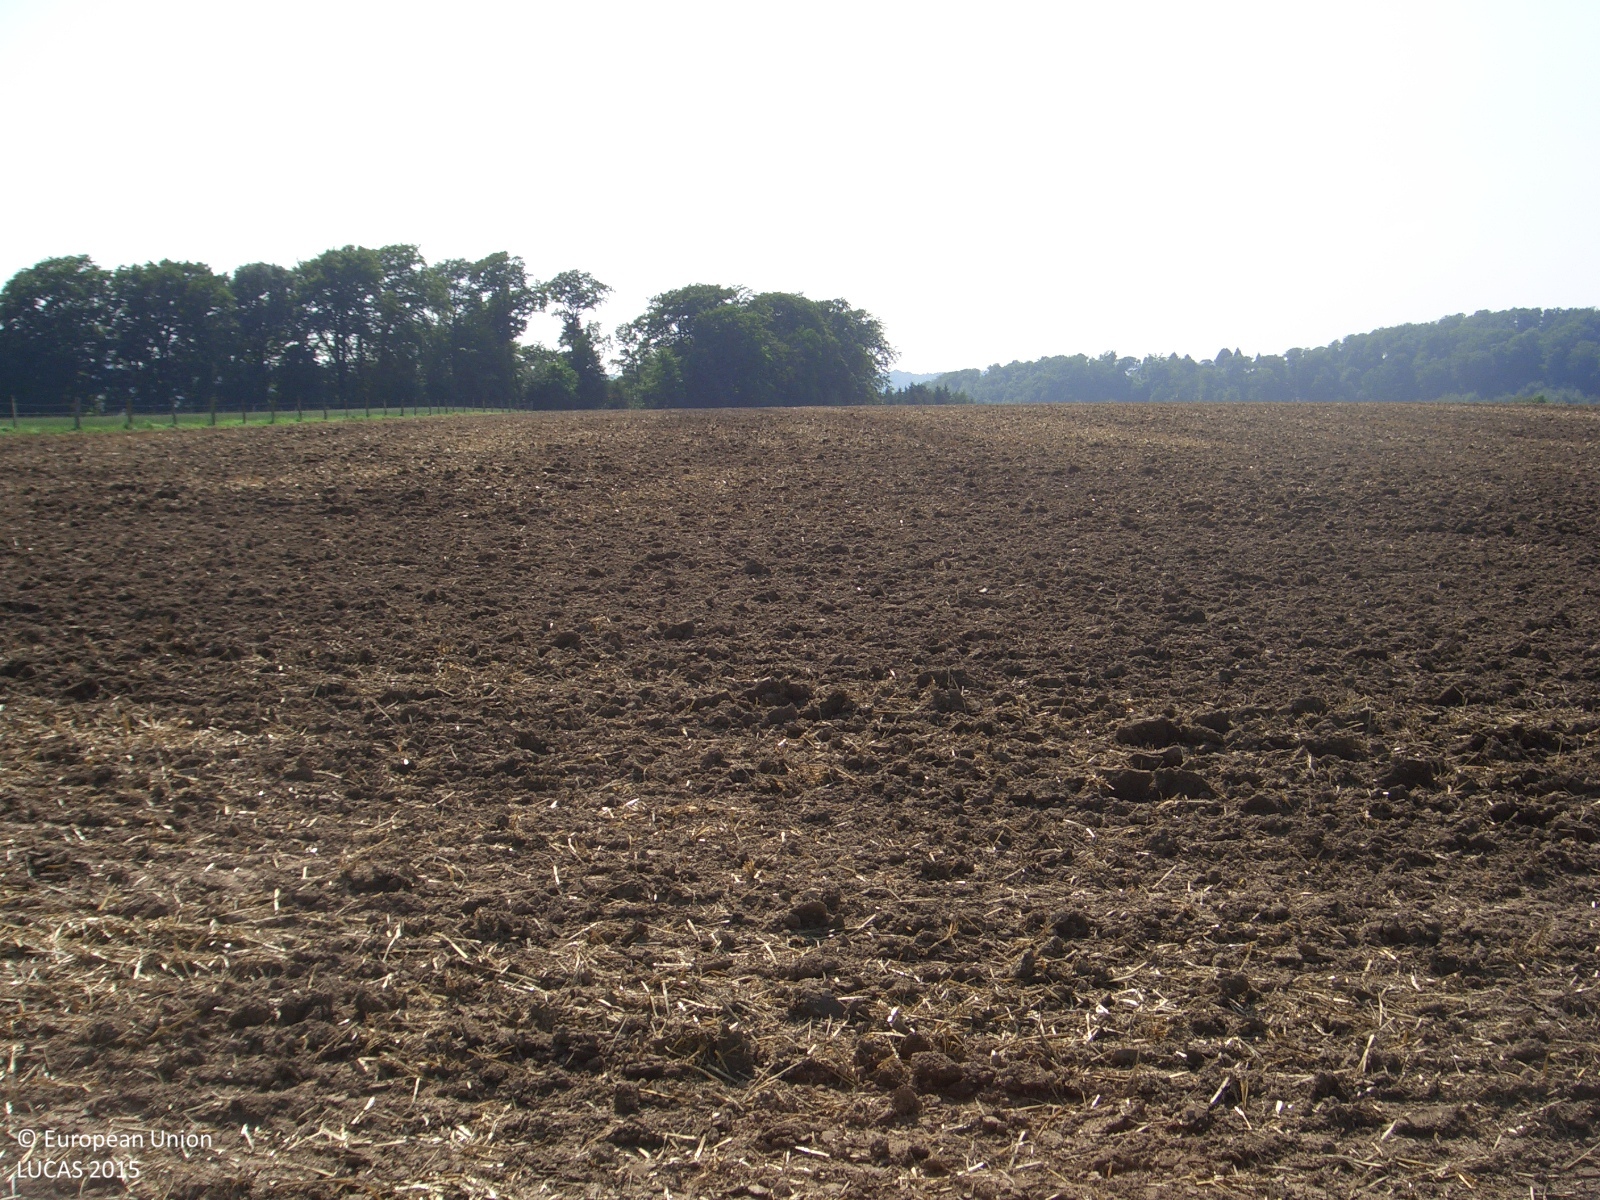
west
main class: Cropland
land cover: Barley
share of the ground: < 10 %
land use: Agriculture (excluding fallow land and kitchen gardens)
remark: Harvested field
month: July
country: DE
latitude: 51.3674
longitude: 6.9692
